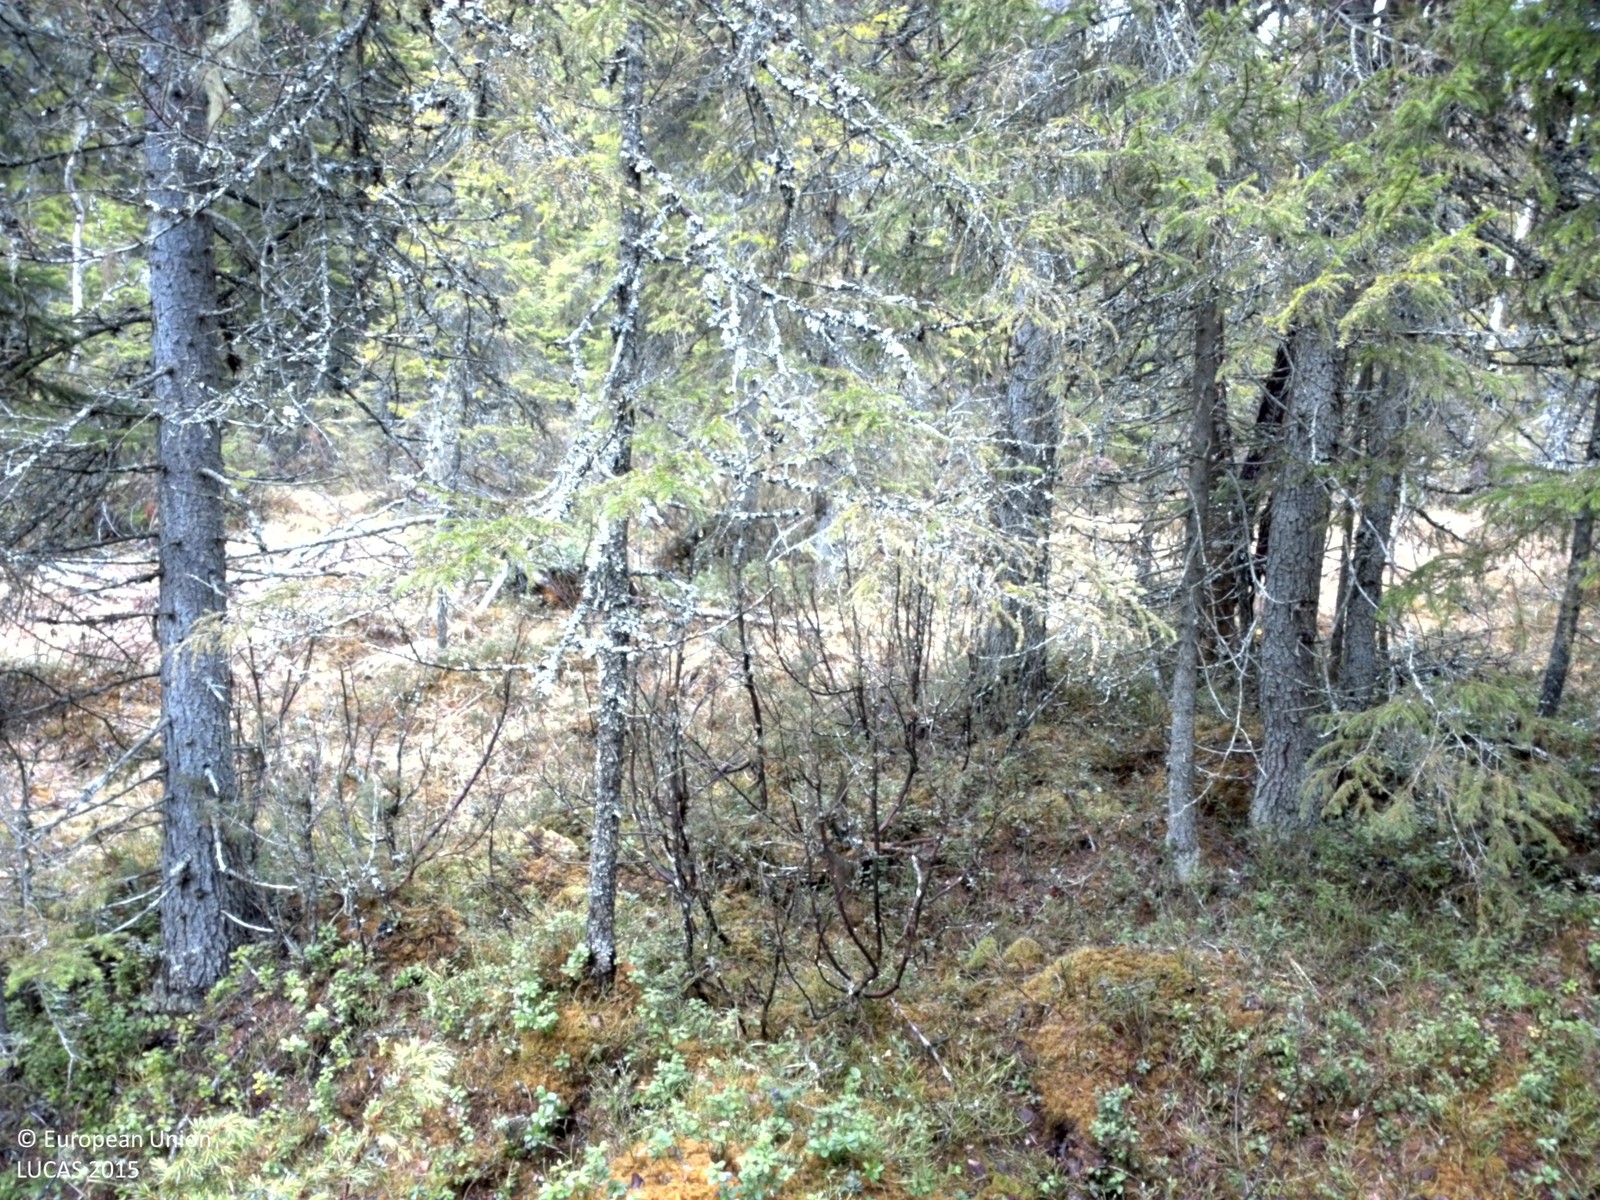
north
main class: Woodland
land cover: Spruce dominated coniferous woodland
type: boreal forest
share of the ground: > 75 %
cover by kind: coniferous forest trees 75 %, shrubs 20 %, broadleaved forest trees 5 %
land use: Forestry
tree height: > 5 m
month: May
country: SE
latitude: 63.4478
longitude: 13.8503
